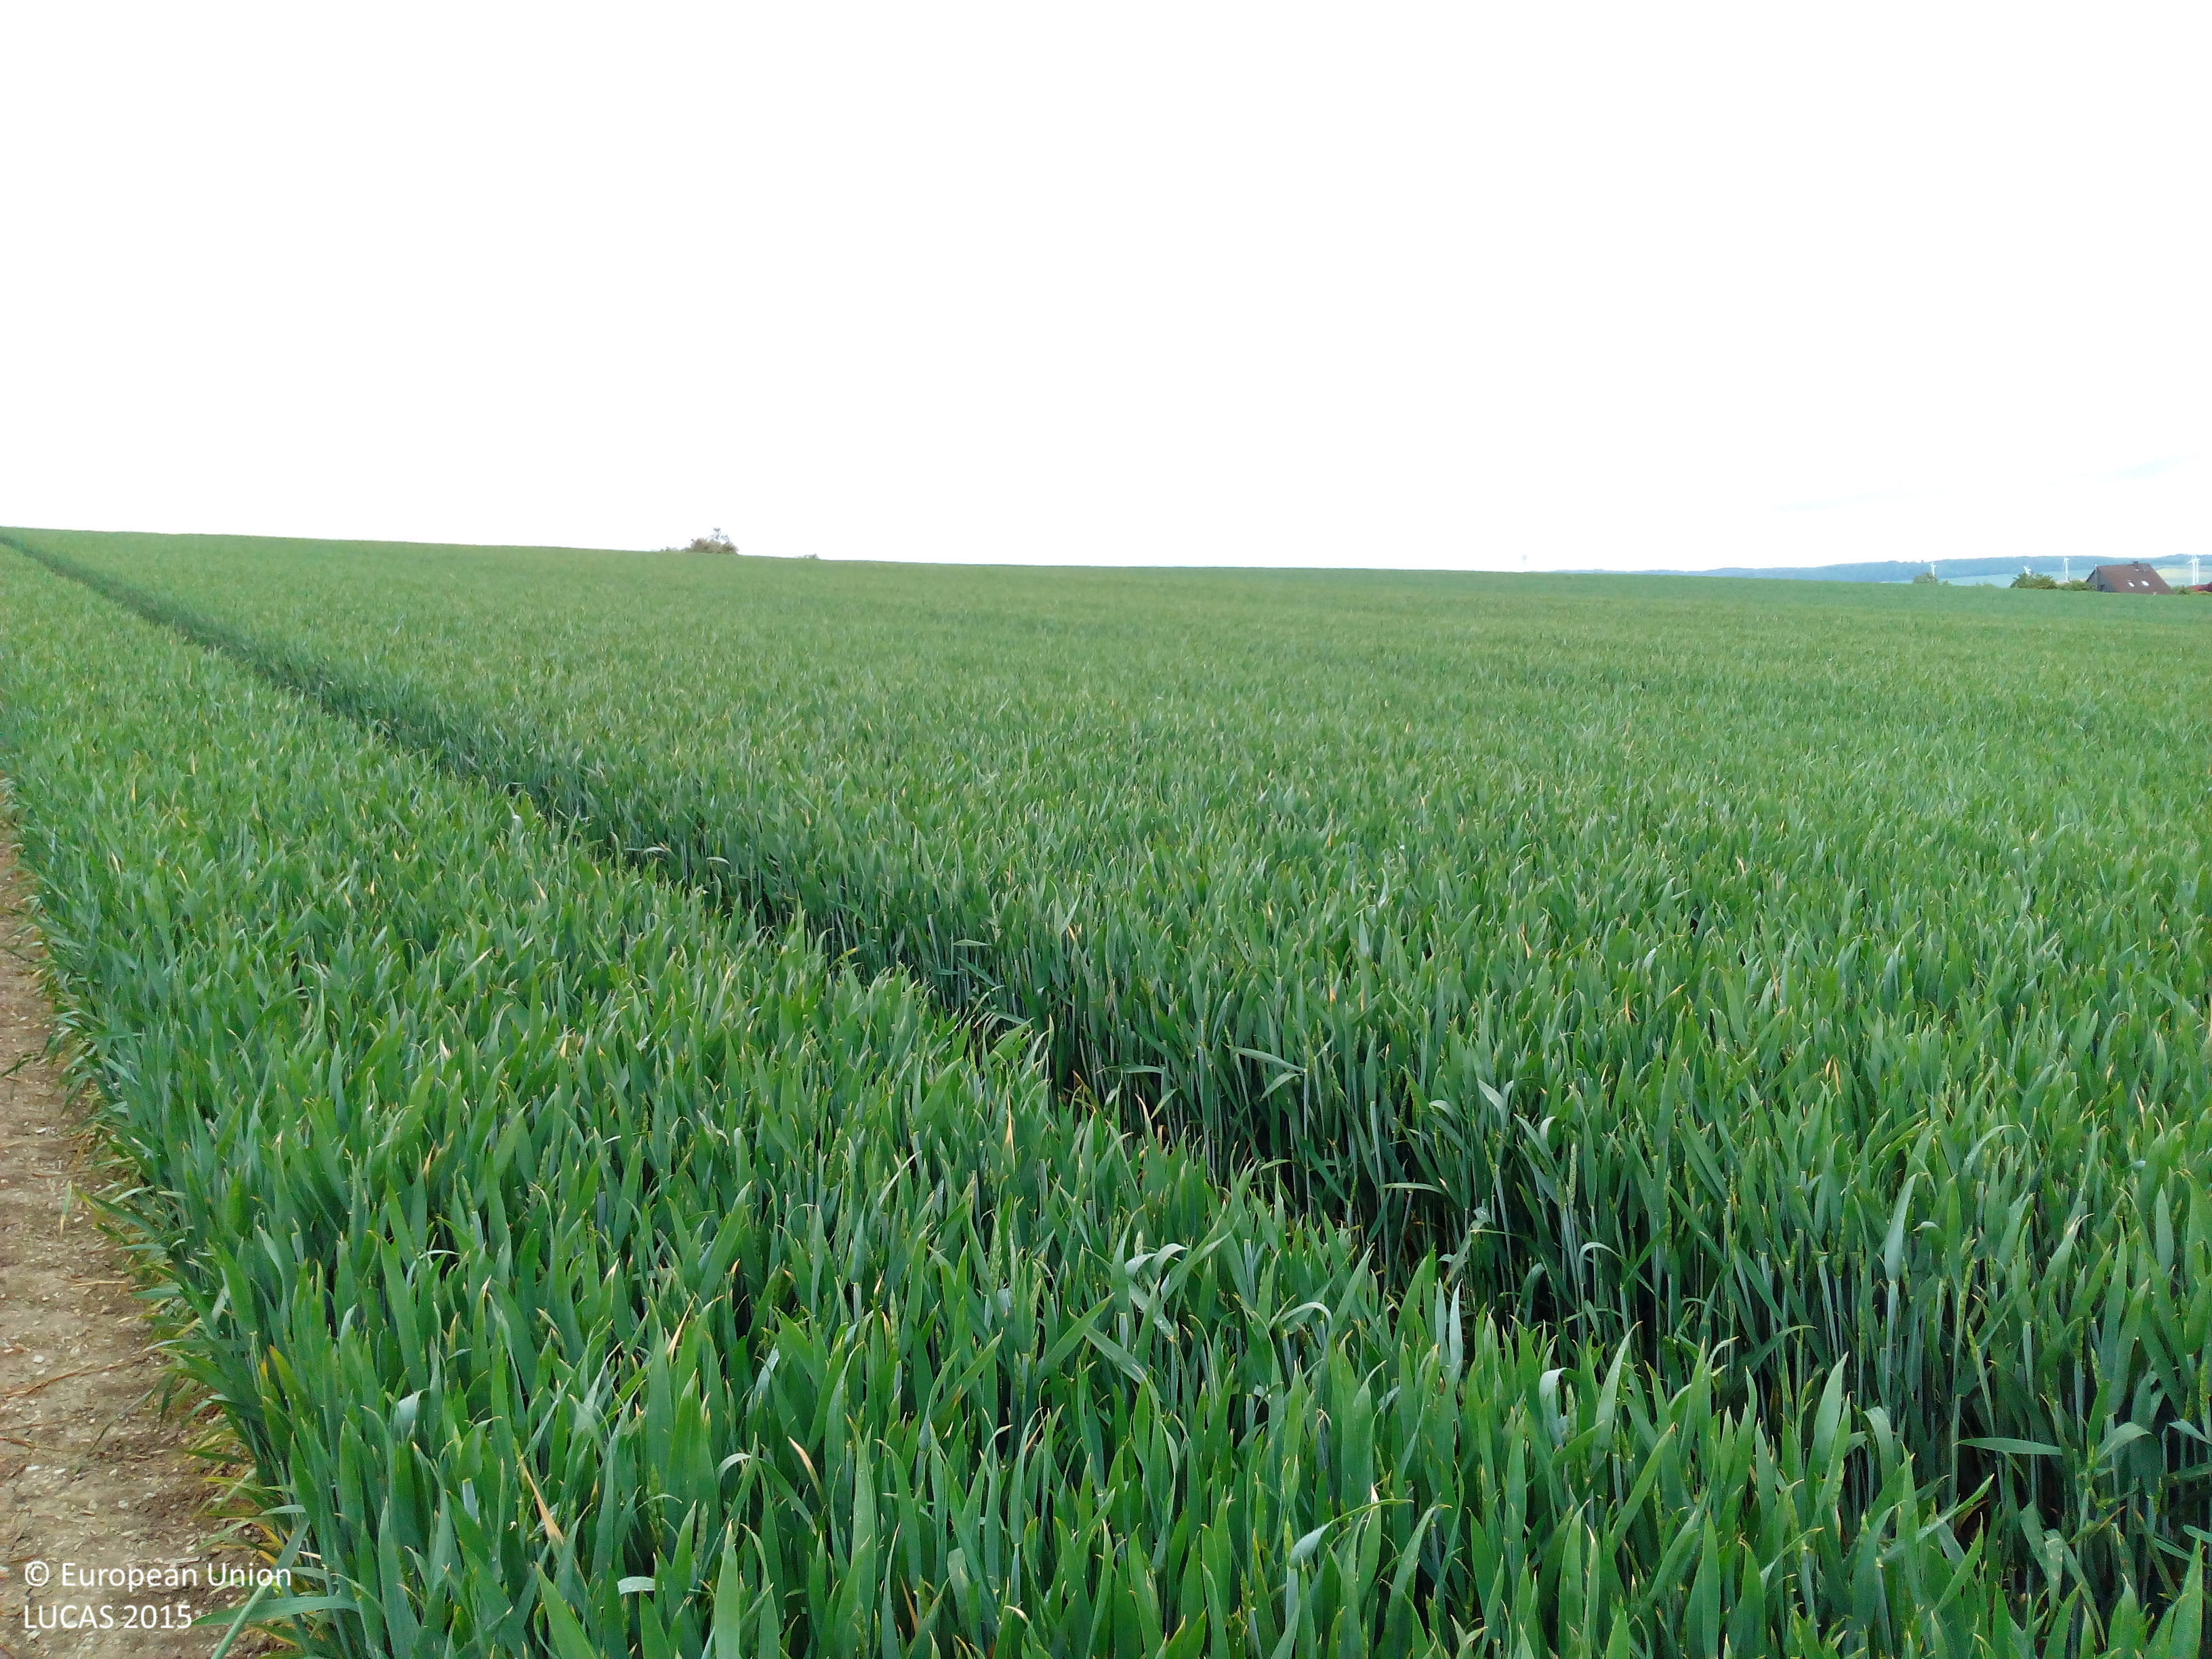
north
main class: Cropland
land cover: Rape and turnip rape
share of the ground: > 75 %
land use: Agriculture (excluding fallow land and kitchen gardens)
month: May
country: DE
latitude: 52.0000
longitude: 9.9272
